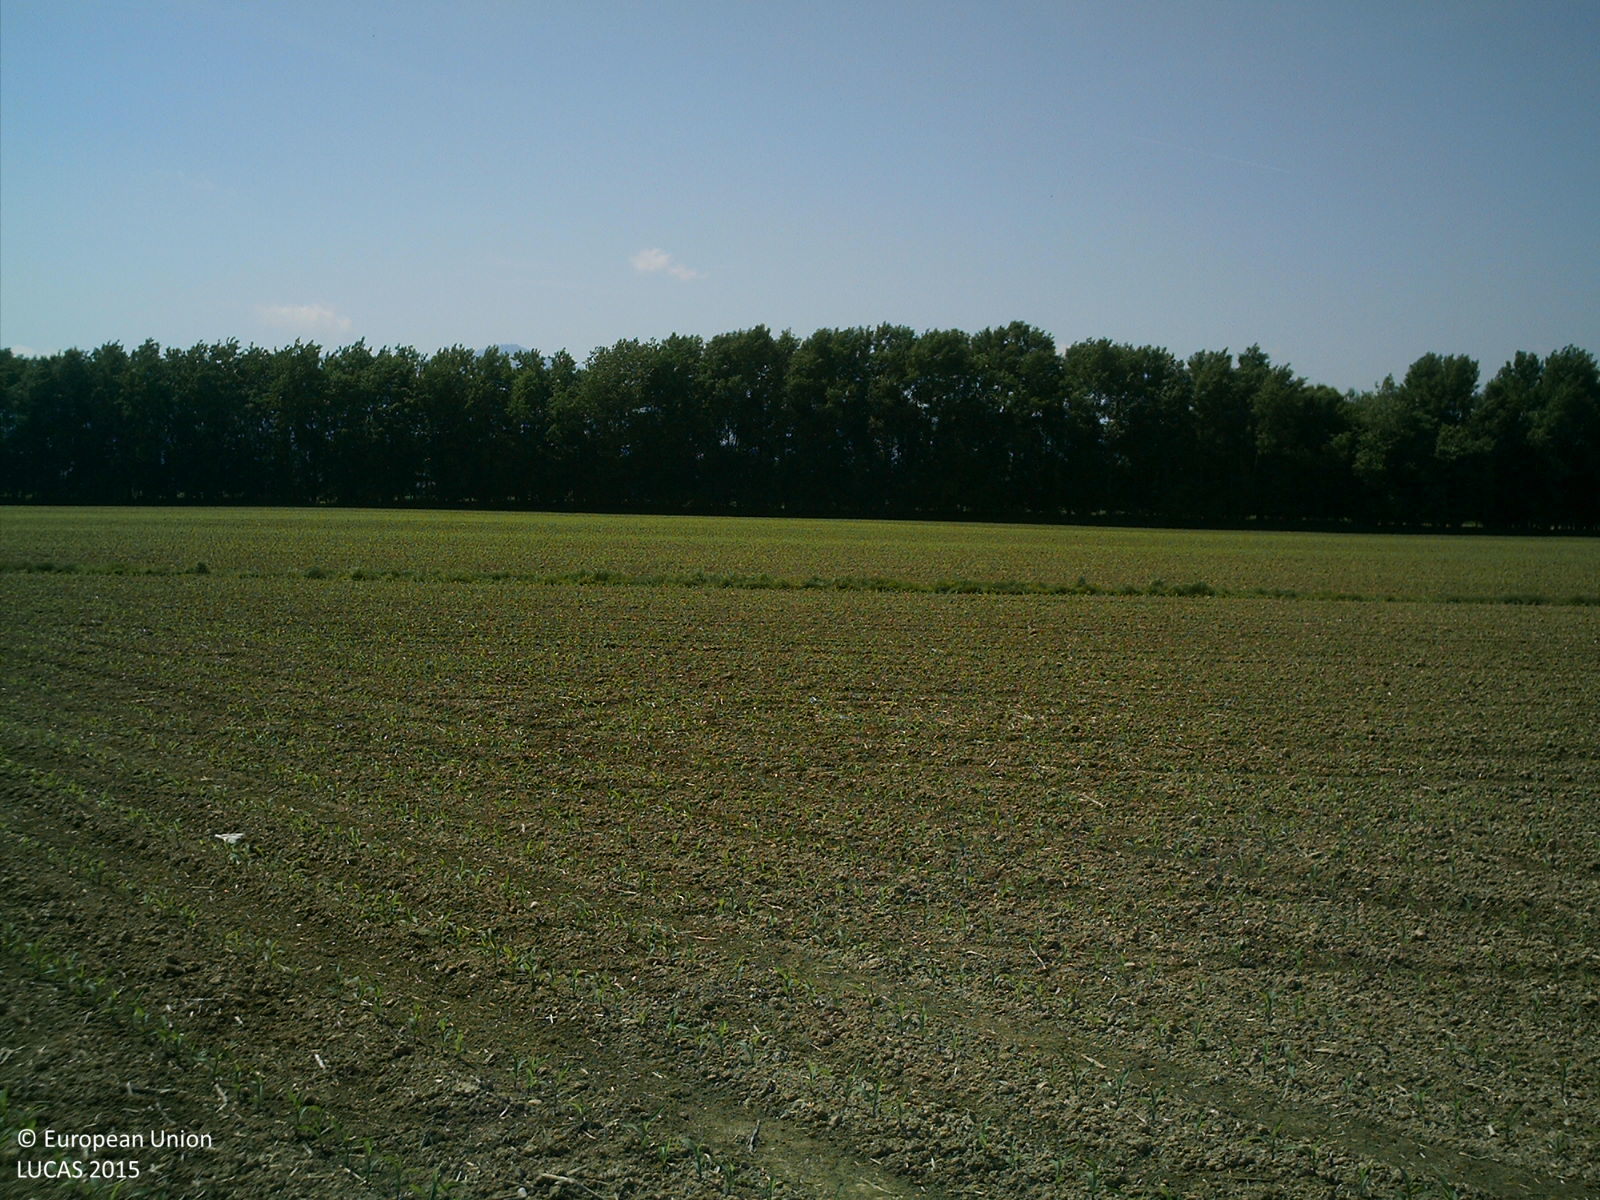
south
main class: Cropland
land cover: Maize
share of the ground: < 10 %
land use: Agriculture (excluding fallow land and kitchen gardens)
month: May
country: AT
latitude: 47.9886
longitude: 14.0059
